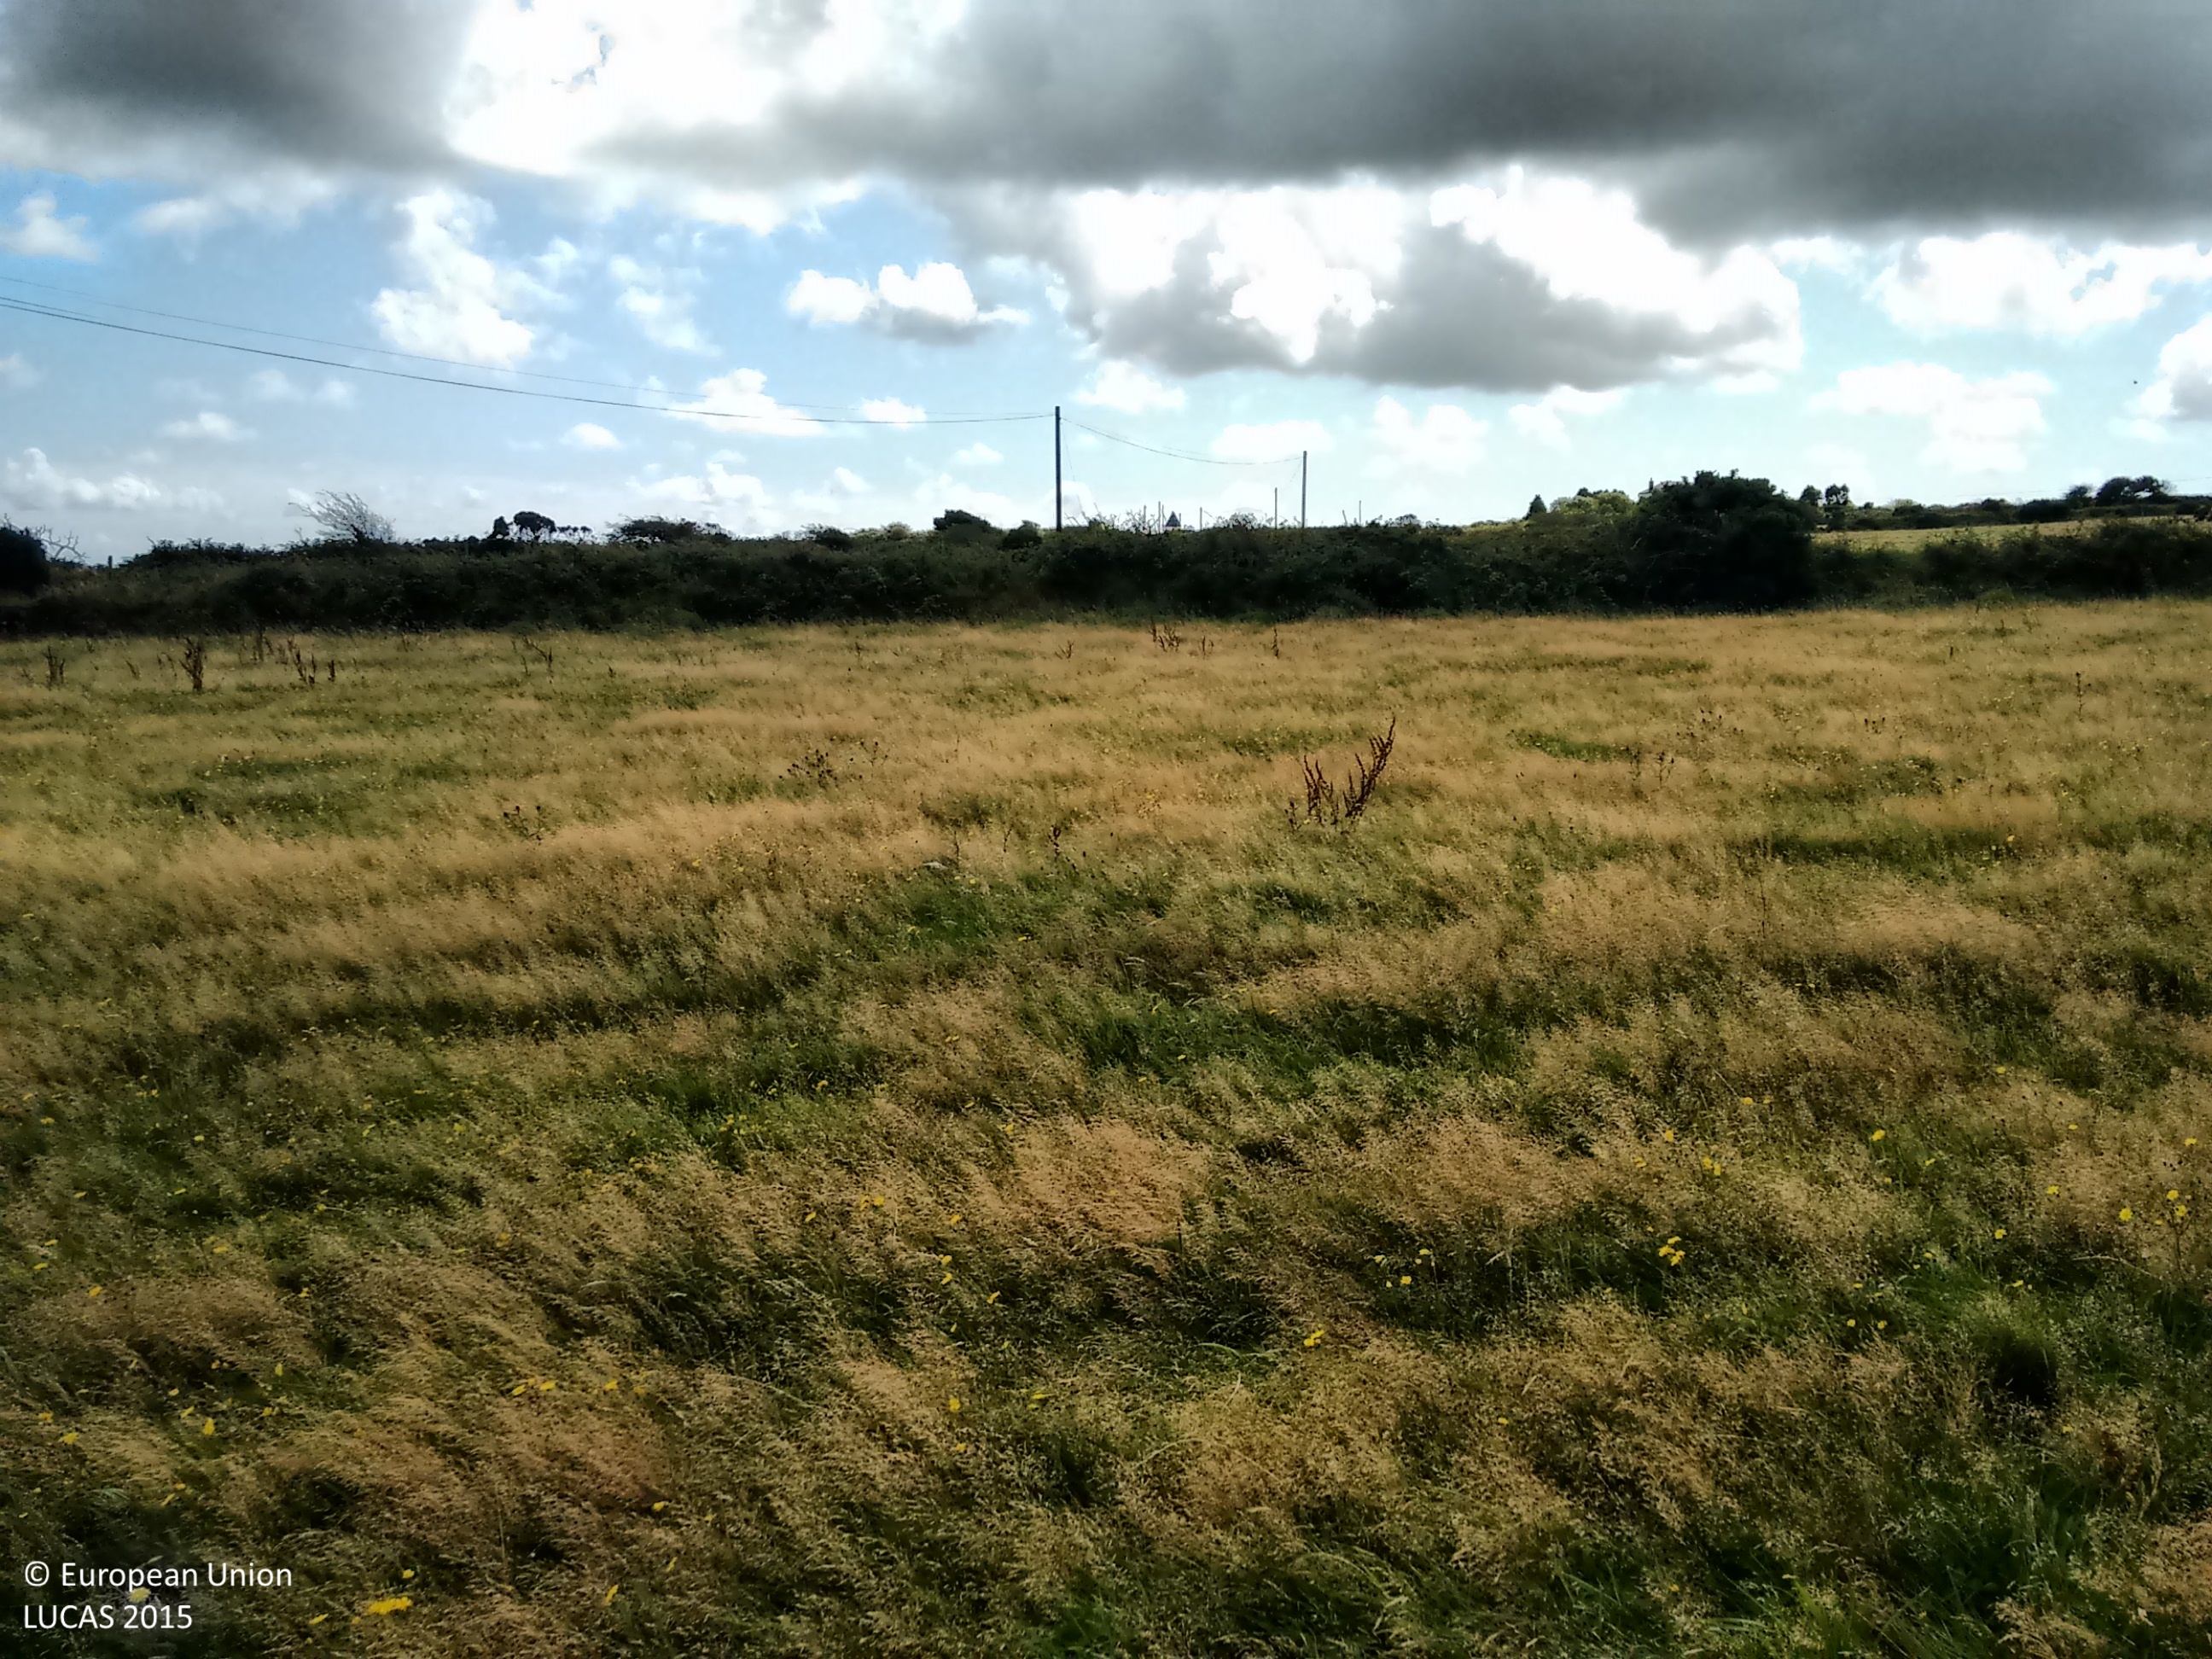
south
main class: Grassland
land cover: Grassland without tree/shrub cover
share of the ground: > 75 %
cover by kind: herbaceous plants 100 %
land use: Agriculture (excluding fallow land and kitchen gardens)
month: August
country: GB
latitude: 50.2169
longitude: -5.2142
